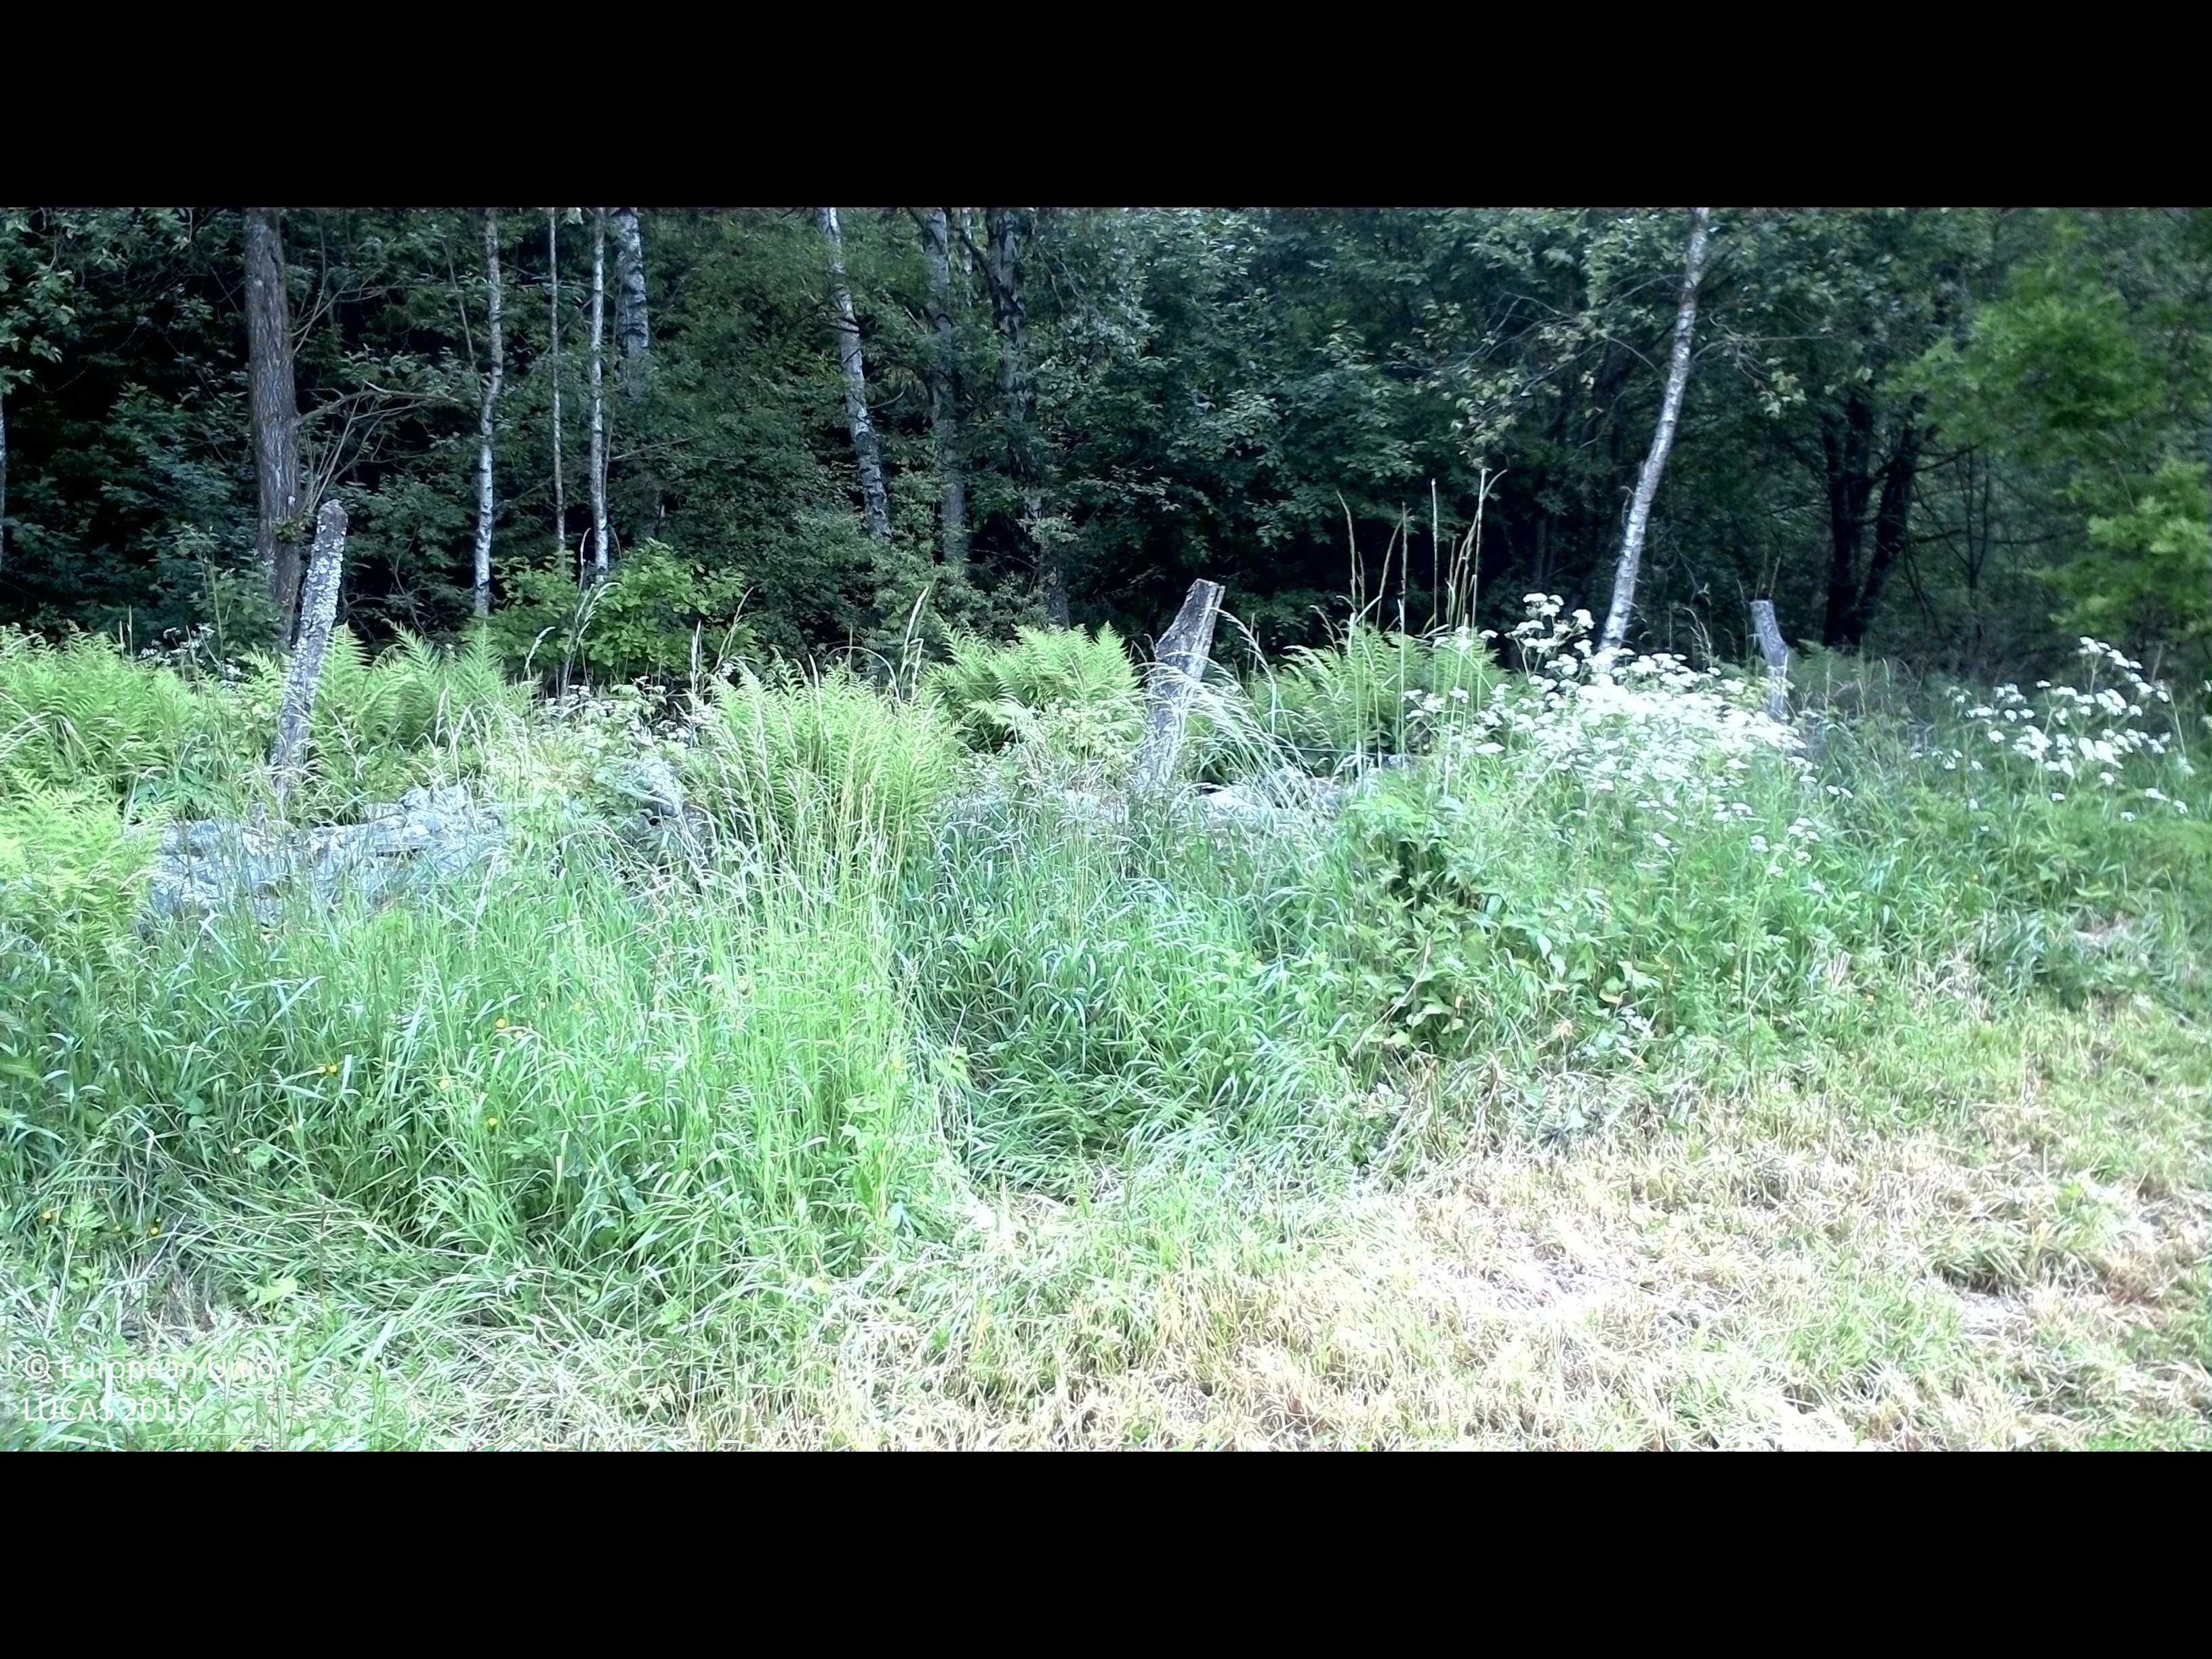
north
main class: Grassland
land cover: Grassland without tree/shrub cover
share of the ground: > 75 %
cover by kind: herbaceous plants 100 %
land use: Agriculture (excluding fallow land and kitchen gardens)
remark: Harvested field
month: June
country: SE
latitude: 55.8552
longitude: 14.0078
